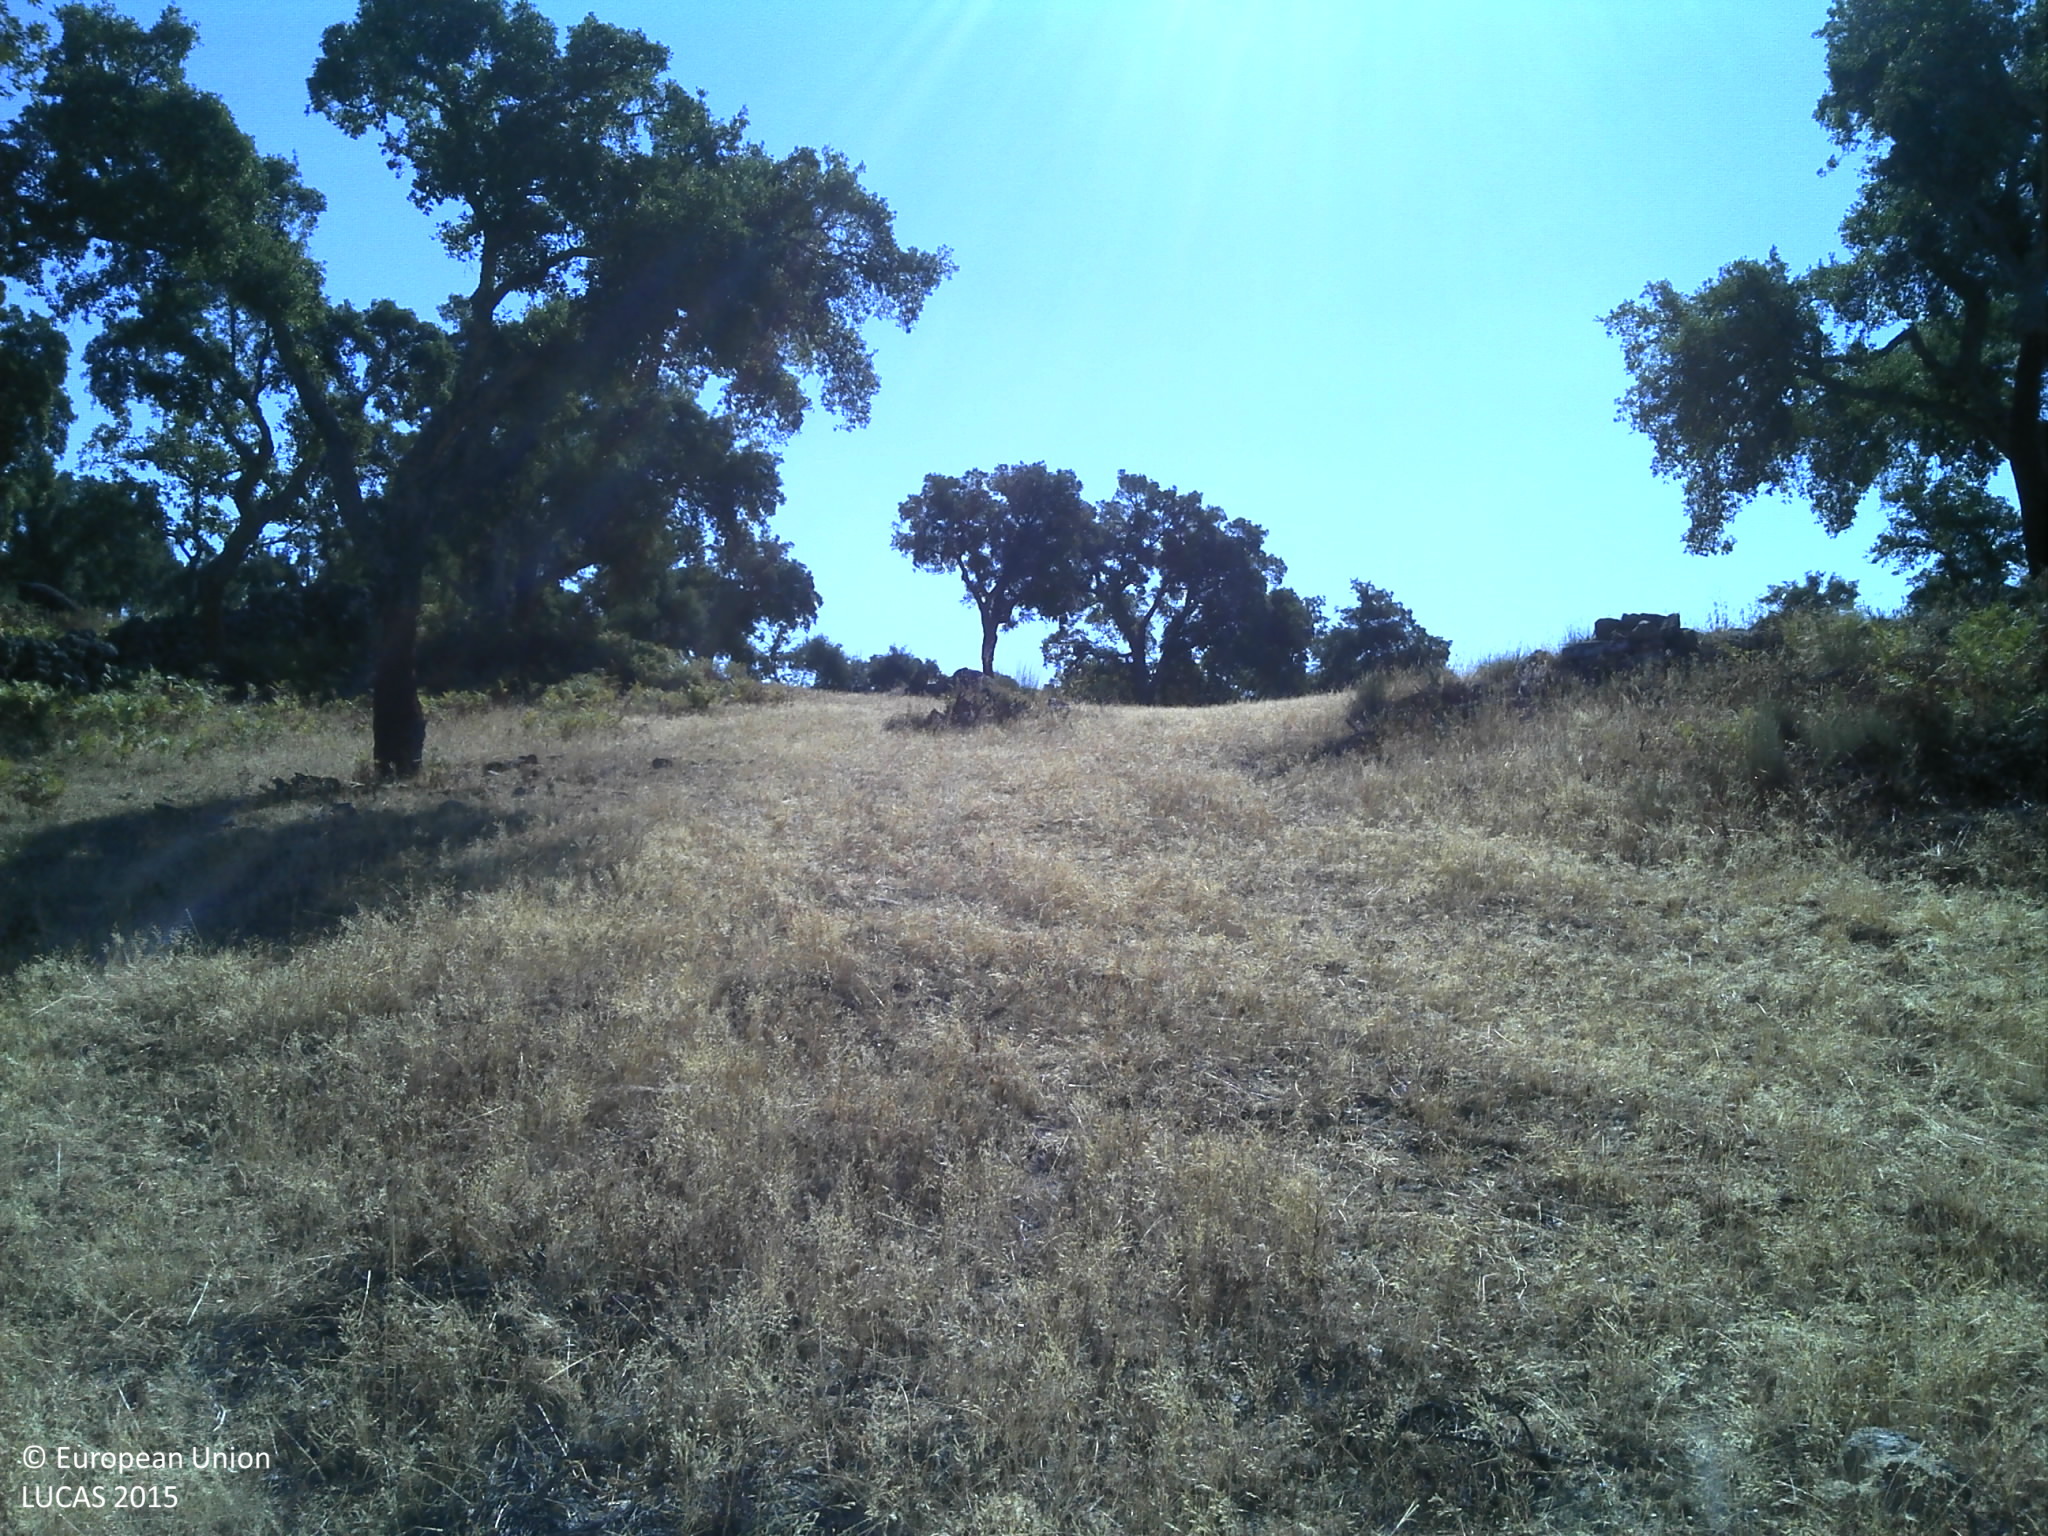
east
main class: Woodland
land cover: Broadleaved woodland
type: broadleaved evergreen forest
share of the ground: 10 - 25 %
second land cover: Grassland without tree/shrub cover
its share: 50 - 75 %
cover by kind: herbaceous plants 60 %, broadleaved forest trees 15 %, unconsolidated bare surface 15 %, consolidated bare surface 10 %
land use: Forestry
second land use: Agriculture (excluding fallow land and kitchen gardens)
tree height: > 5 m
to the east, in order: Broadleaved woodland; Grassland without tree/shrub cover; Rock outcrops; Broadleaved woodland; Rock outcrops; Broadleaved woodland; Grassland without tree/shrub cover; Broadleaved woodland; Rock outcrops
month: August
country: PT
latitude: 39.3833
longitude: -7.4937
